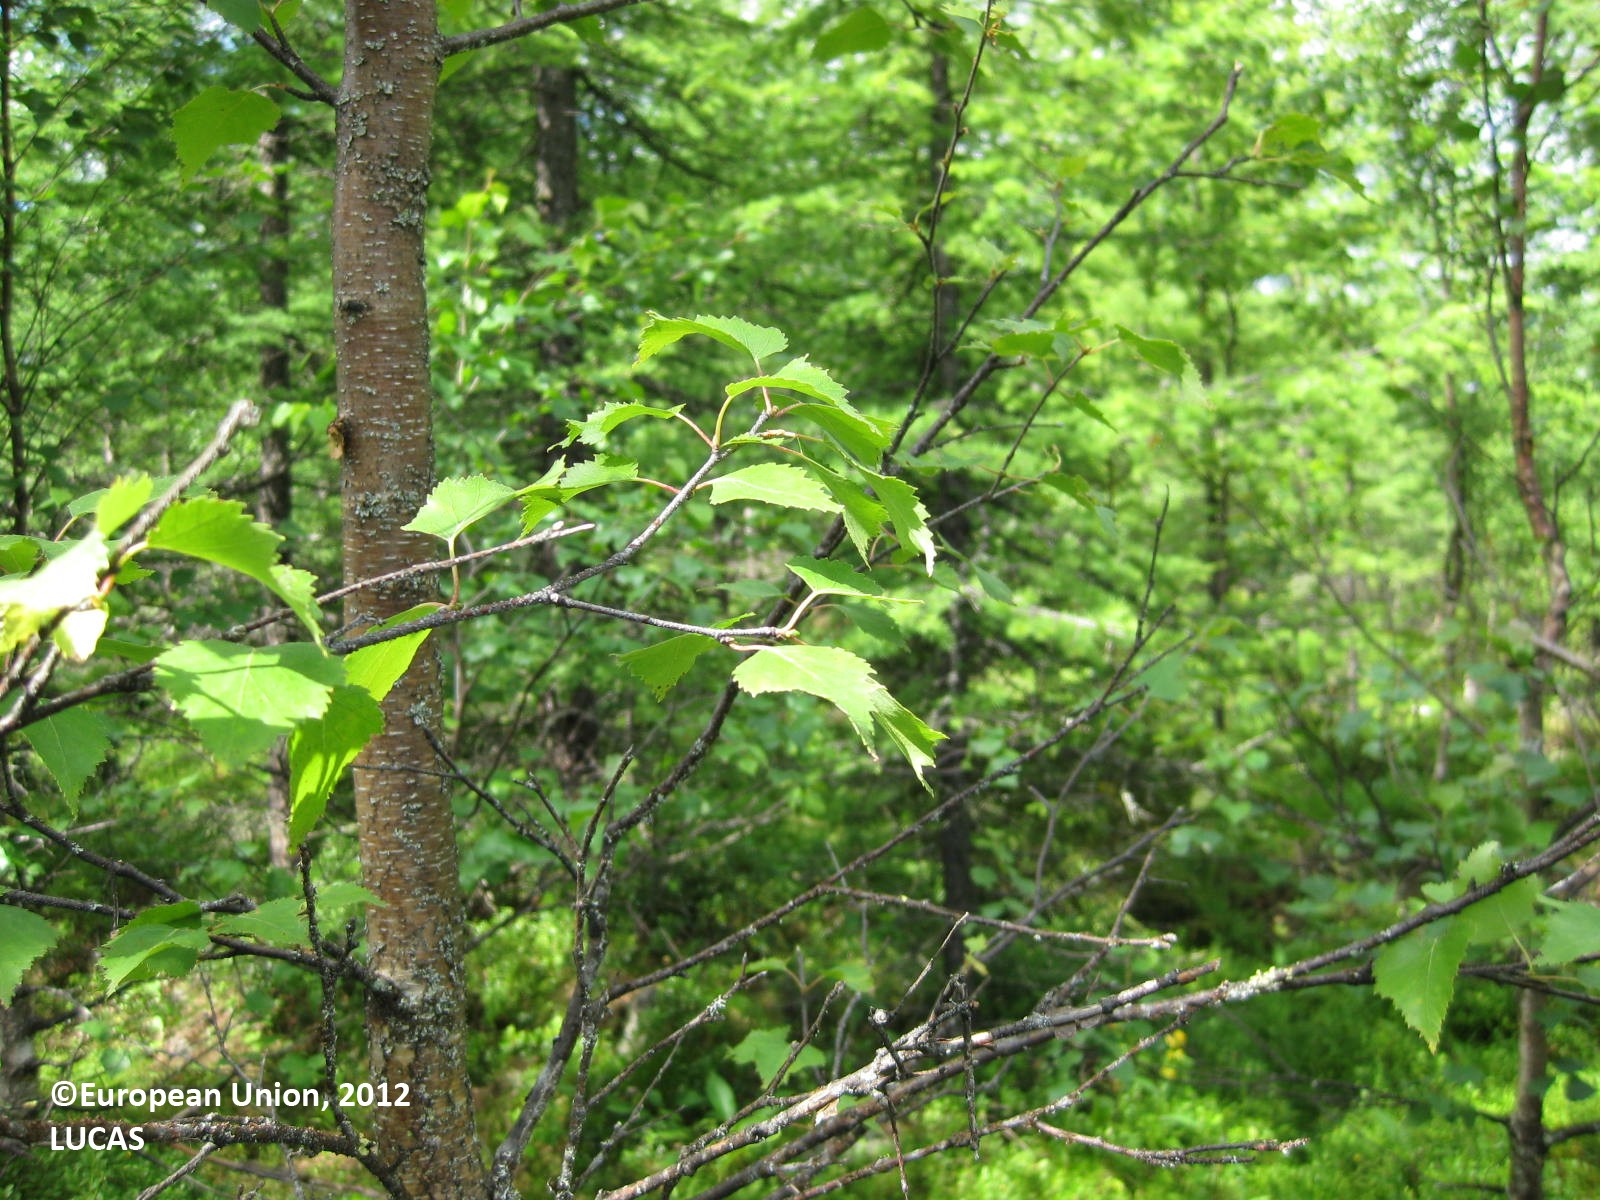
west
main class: Woodland
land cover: Other coniferous woodland
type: boreal forest
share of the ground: 50 - 75 %
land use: Forestry
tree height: > 5 m
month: July
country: FI
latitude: 65.6764
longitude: 28.0958
